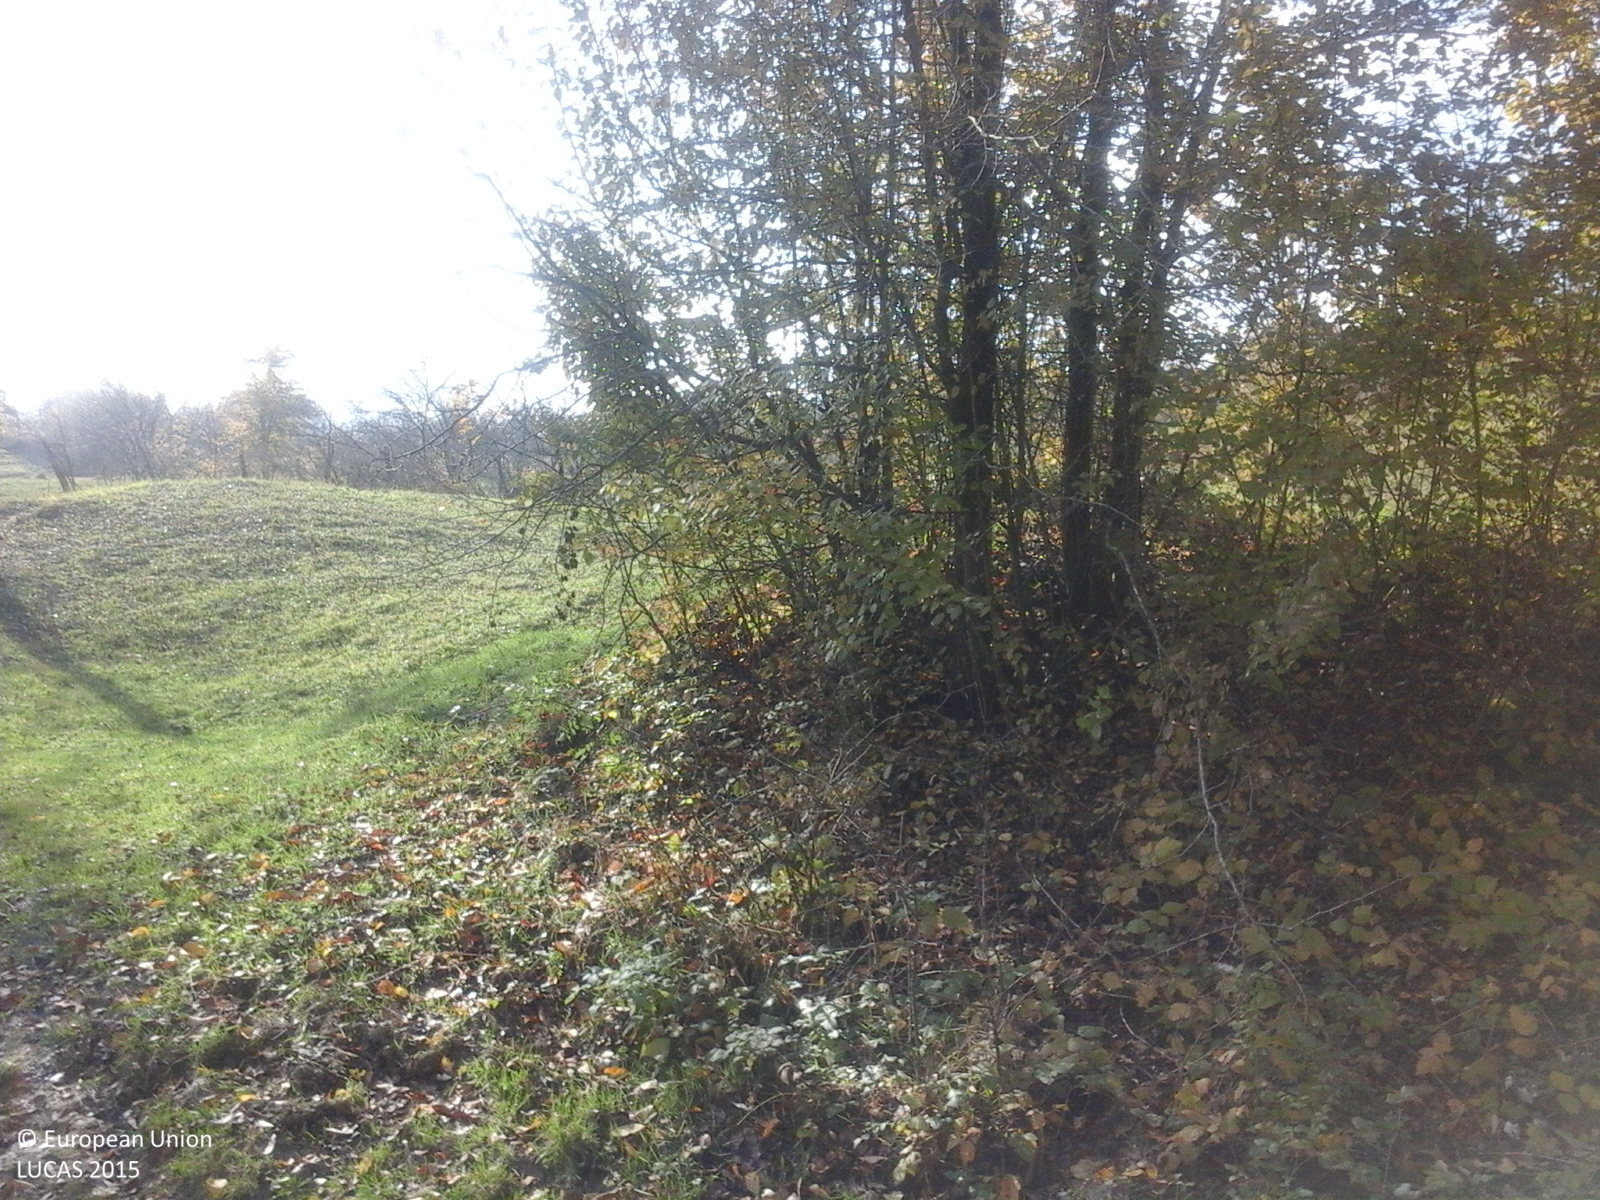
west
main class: Woodland
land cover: Broadleaved woodland
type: non-riverine alder, birch or aspen forest
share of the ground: > 75 %
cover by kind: broadleaved forest trees 100 %
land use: Forestry
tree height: > 5 m
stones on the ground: < 10 %
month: October
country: RO
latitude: 45.4886
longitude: 26.9108
